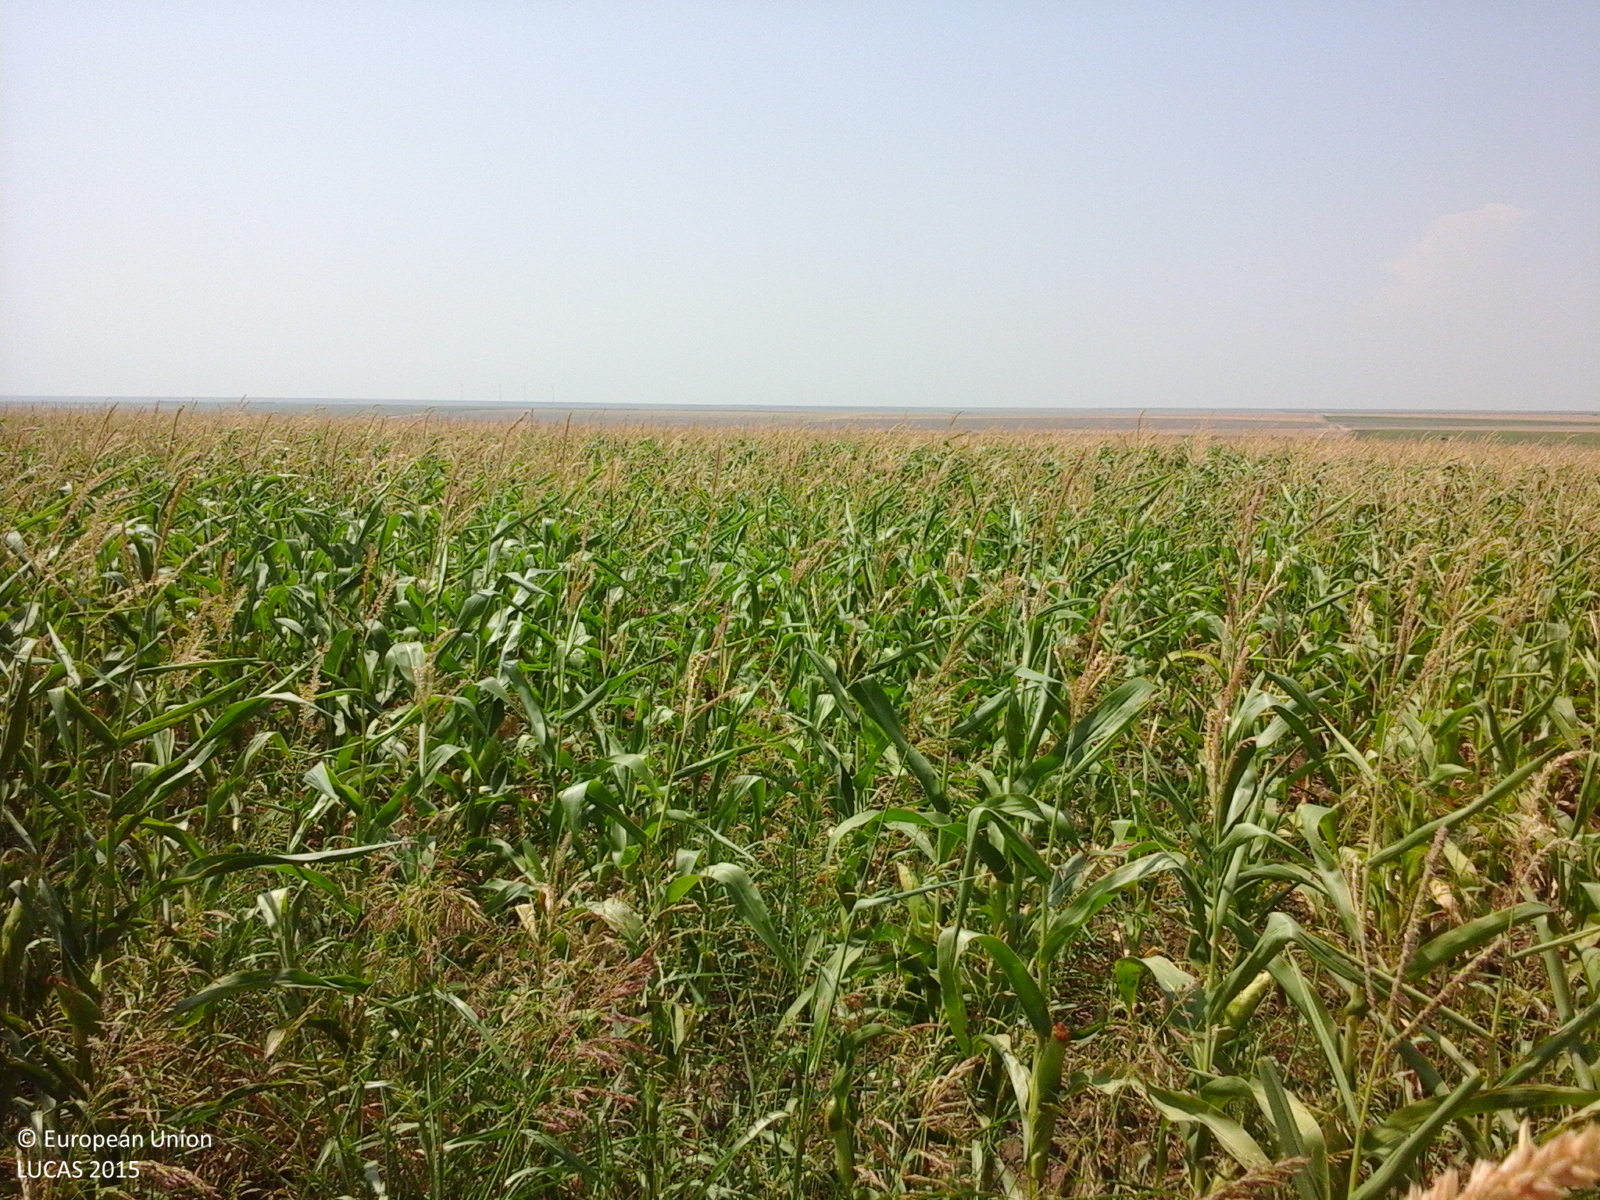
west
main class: Cropland
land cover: Maize
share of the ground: > 75 %
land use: Agriculture (excluding fallow land and kitchen gardens)
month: July
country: RO
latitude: 45.6782
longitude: 27.8705
